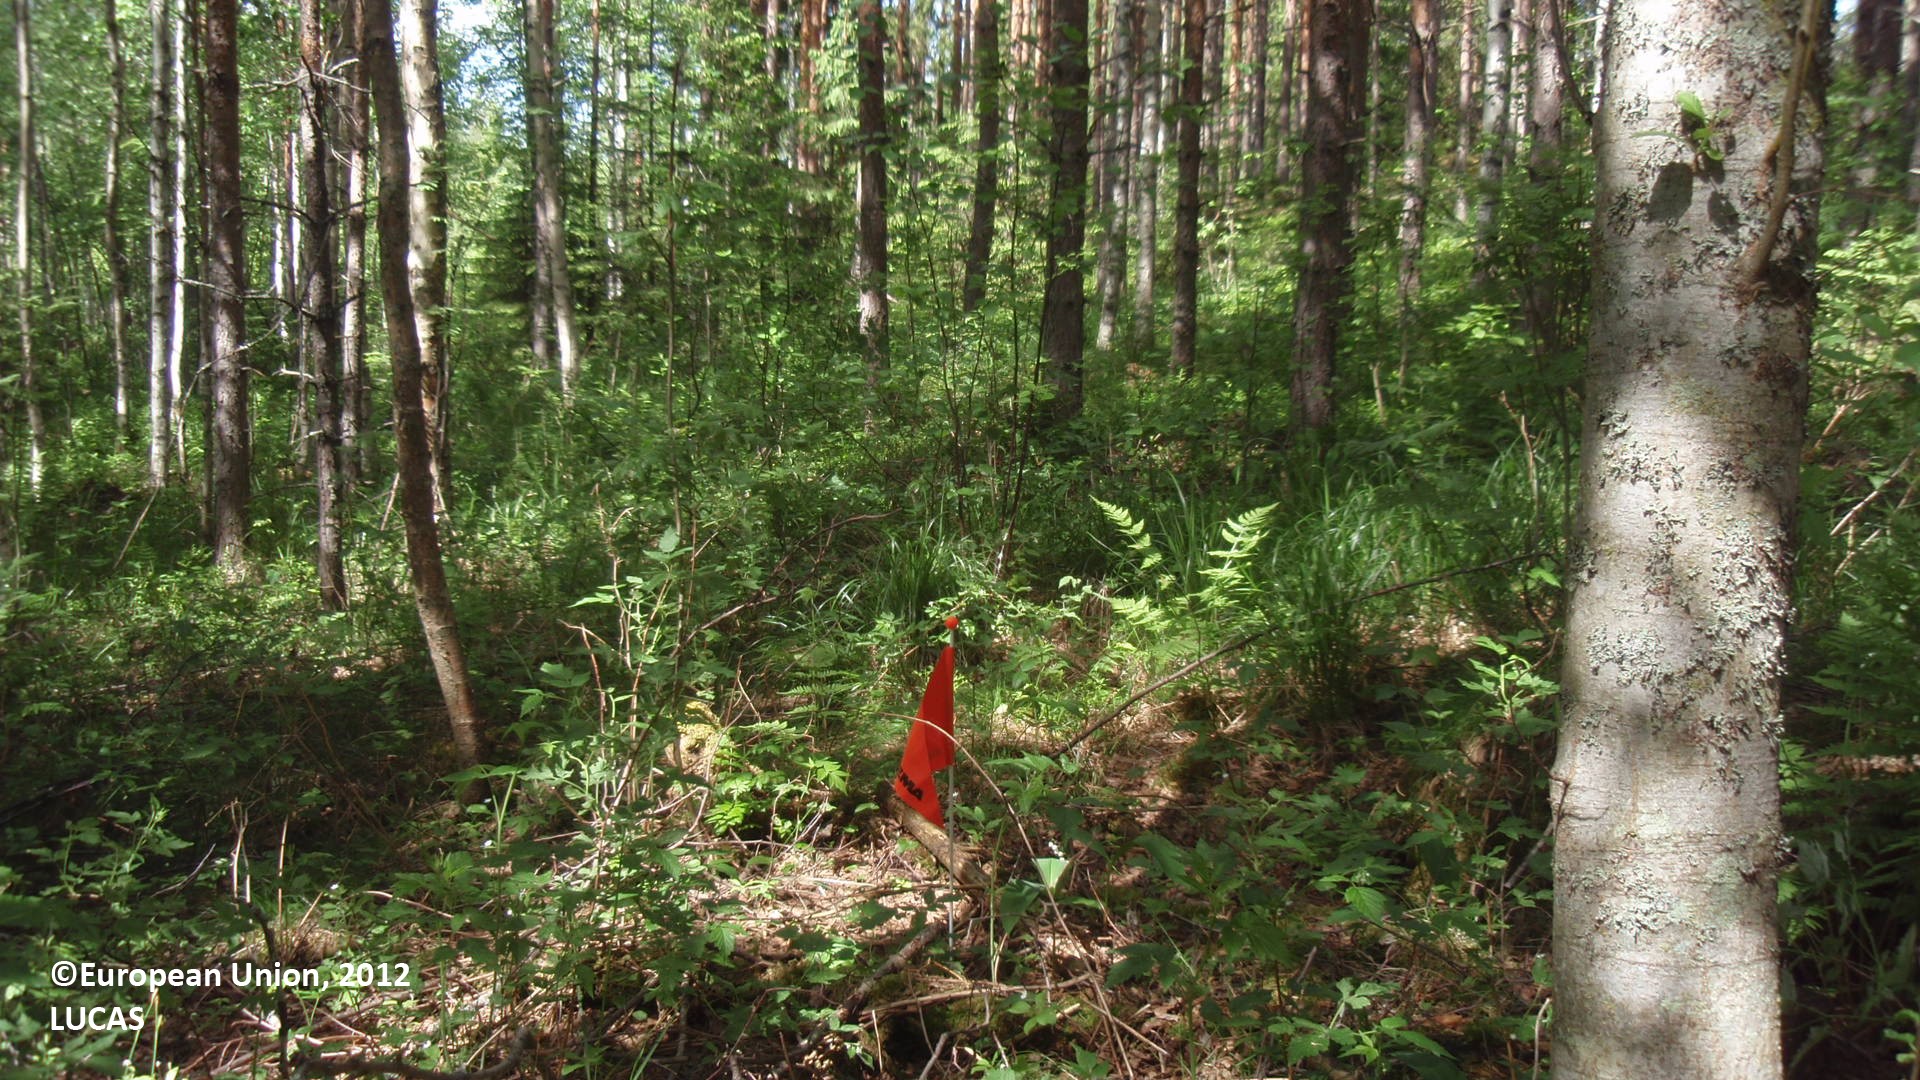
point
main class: Woodland
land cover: Pine dominated mixed woodland
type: boreal forest
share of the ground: > 75 %
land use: Forestry
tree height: > 5 m
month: June
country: FI
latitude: 61.6277
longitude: 28.4112
